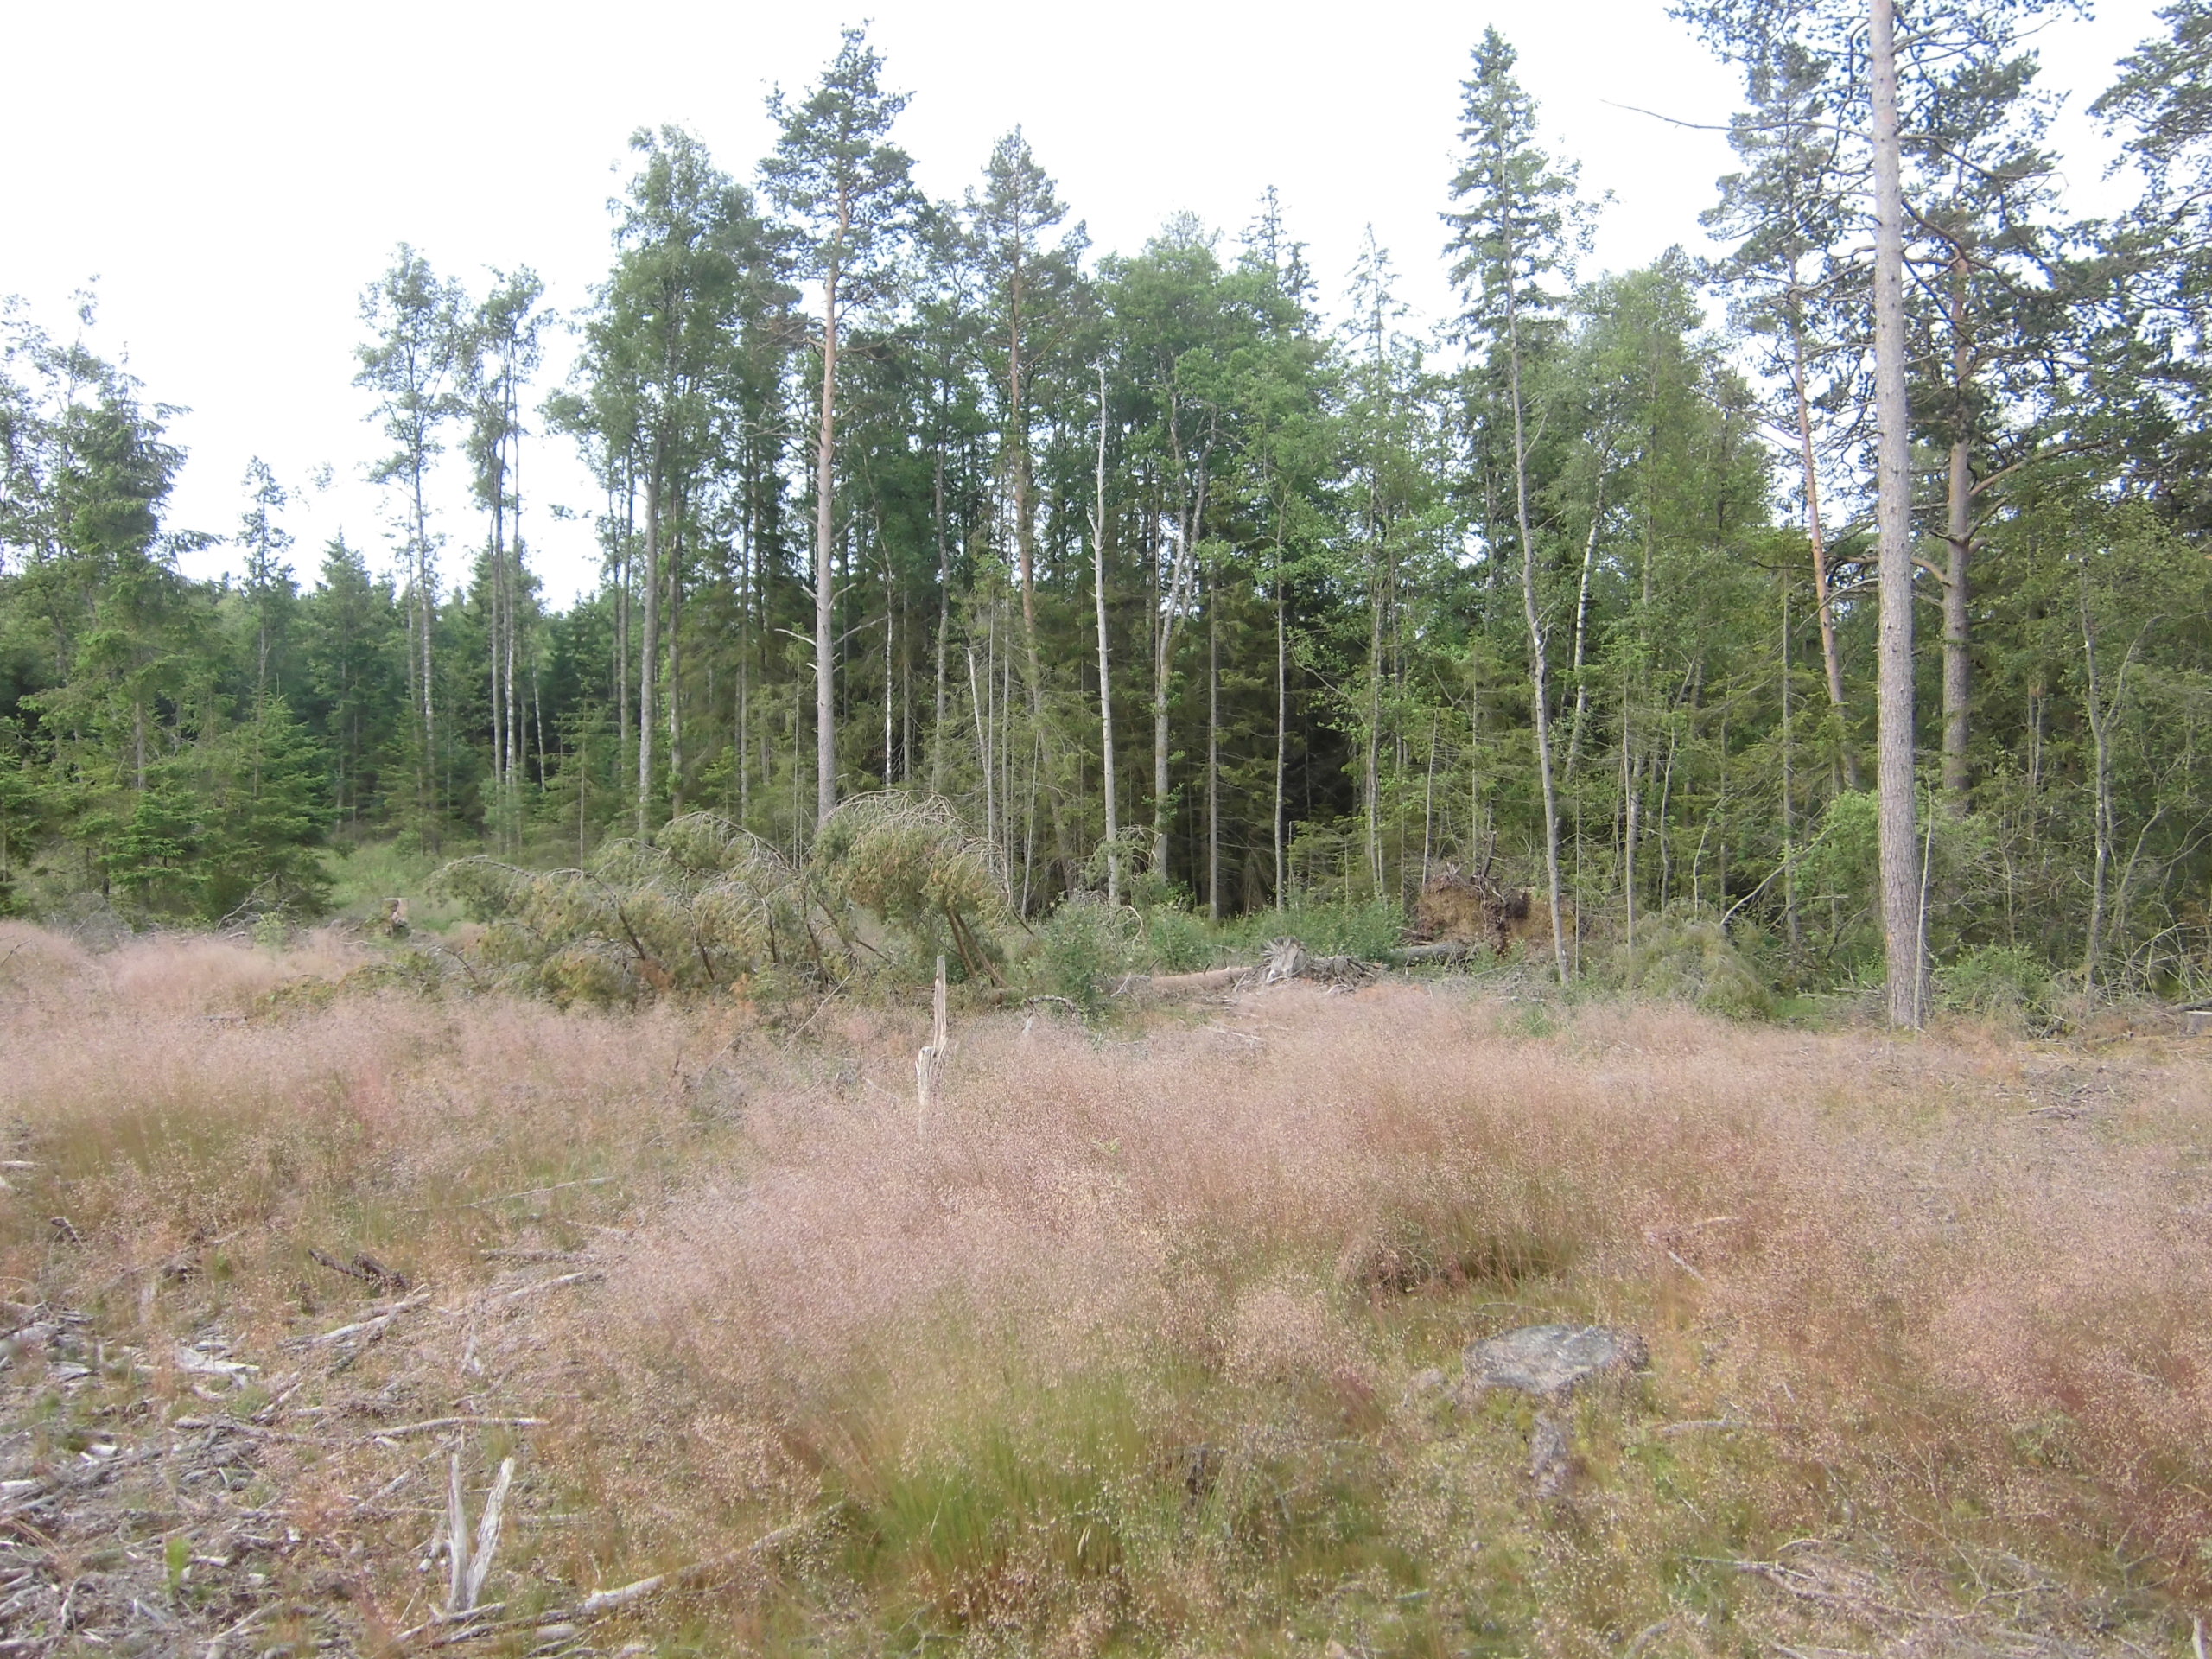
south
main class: Grassland
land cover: Grassland with sparse tree/shrub cover
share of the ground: > 75 %
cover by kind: herbaceous plants 70 %, lichens and mosses 10 %, unconsolidated bare surface 10 %, broadleaved forest trees 5 %, shrubs 5 %
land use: Forestry
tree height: < 5 m
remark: Clear cut
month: July
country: SE
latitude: 57.3961
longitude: 14.7717
